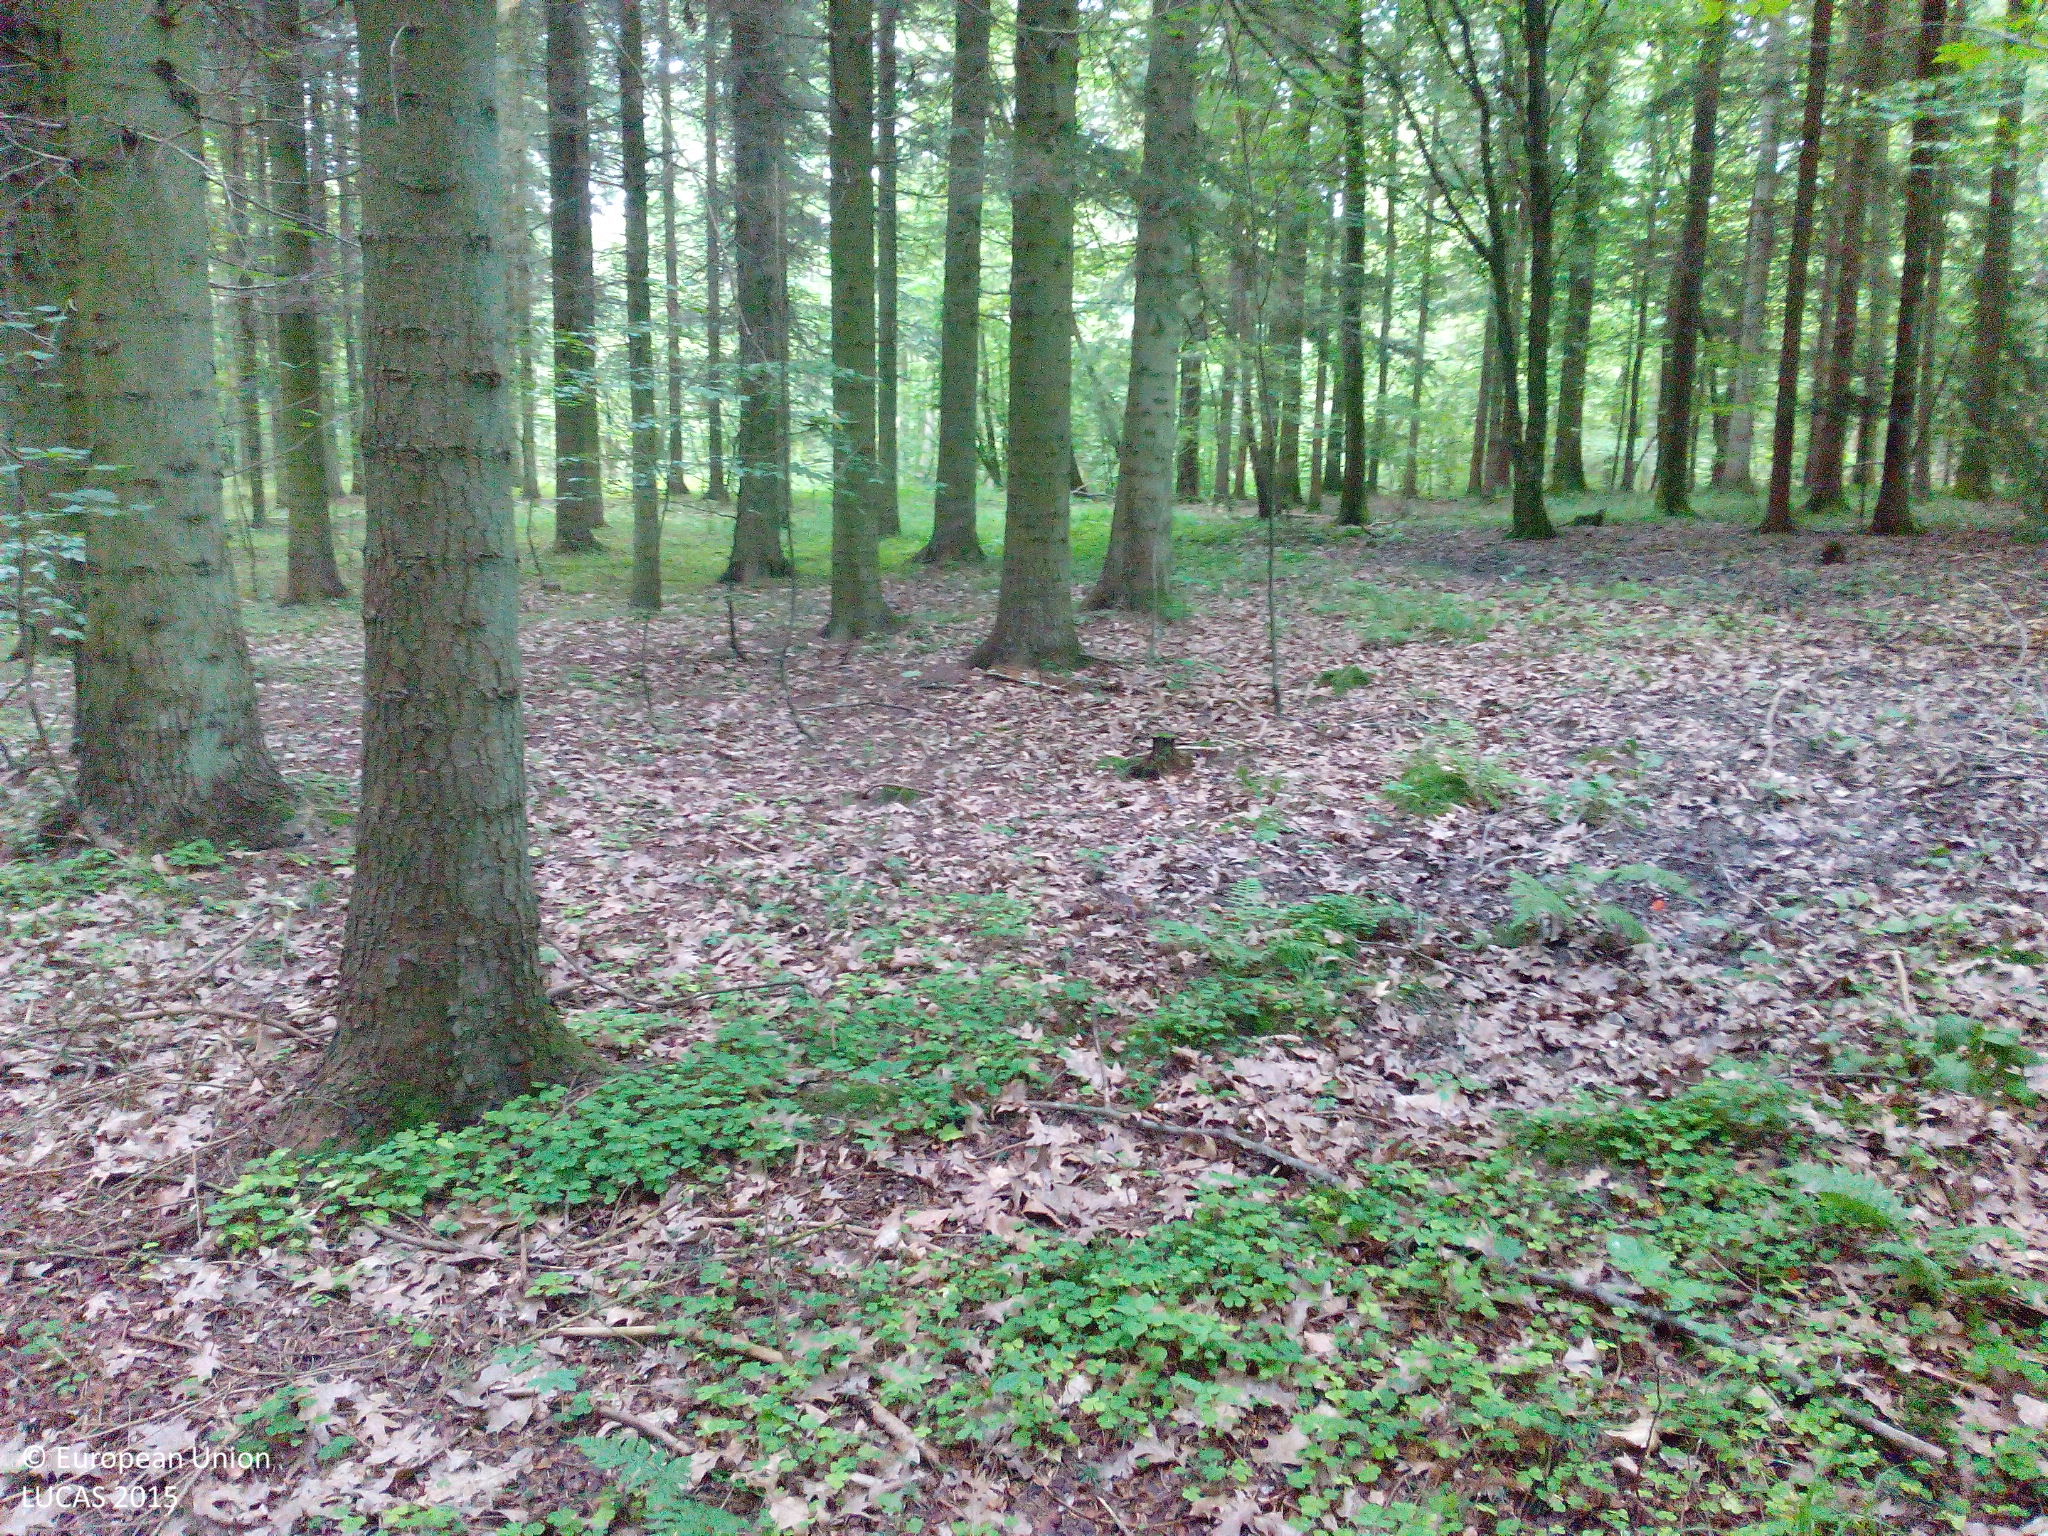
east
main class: Woodland
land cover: Other coniferous woodland
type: acidophilous oak and oak-birch forest
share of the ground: > 75 %
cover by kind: coniferous forest trees 70 %, broadleaved forest trees 20 %, herbaceous plants 5 %, unconsolidated bare surface 5 %
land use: Forestry
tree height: > 5 m
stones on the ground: 10 - 25 %
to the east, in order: Other coniferous woodland; Other mixed woodland; Broadleaved woodland; Ditches and canals; Broadleaved woodland; Other mixed woodland; Ditches and canals; Tracks; Other mixed woodland; Ditches and canals; Other mixed woodland; Tracks; Other mixed woodland; Tracks; Other mixed woodland
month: August
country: DK
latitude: 55.5451
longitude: 11.8527
